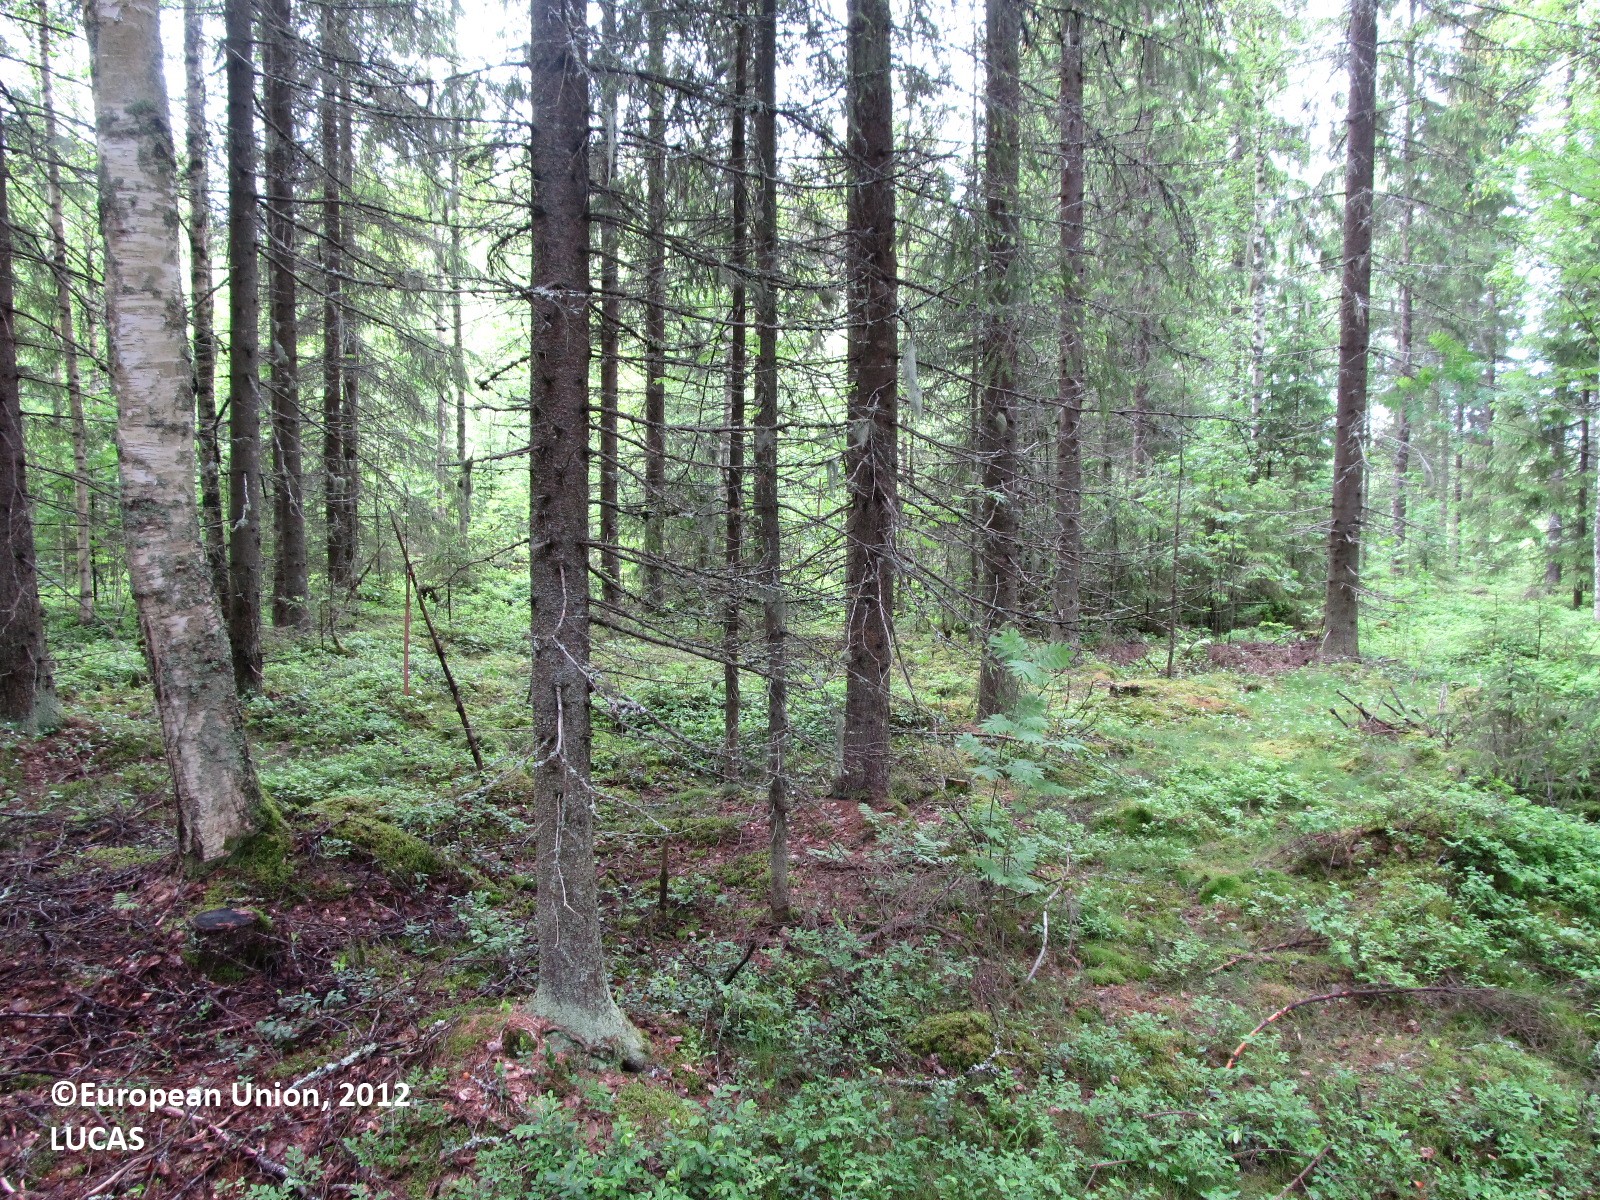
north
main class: Woodland
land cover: Spruce dominated coniferous woodland
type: boreal forest
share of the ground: 25 - 50 %
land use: Forestry
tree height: > 5 m
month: June
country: FI
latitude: 62.9249
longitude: 28.1643
